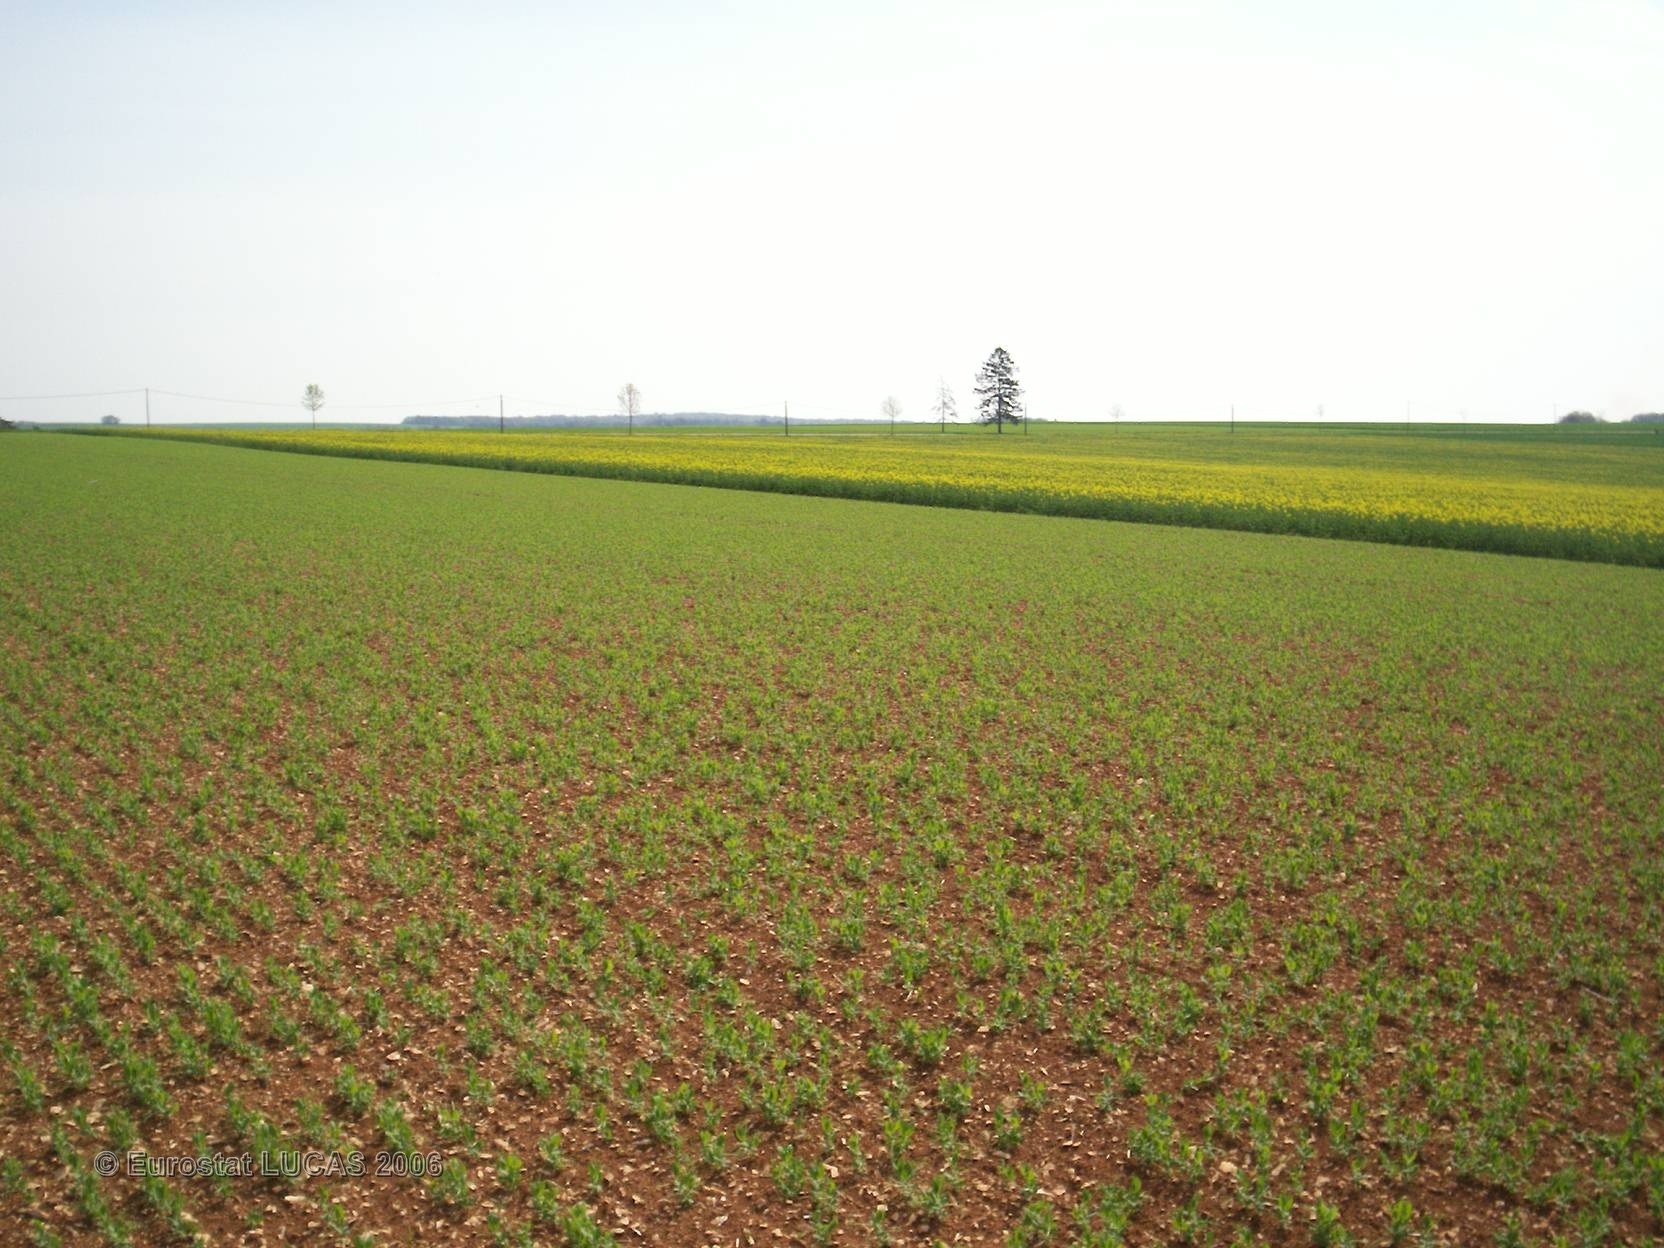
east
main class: Cropland
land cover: Dry pulses
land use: Agriculture (excluding fallow land and kitchen gardens)
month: May
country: FR
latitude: 47.6228
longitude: 4.6101
